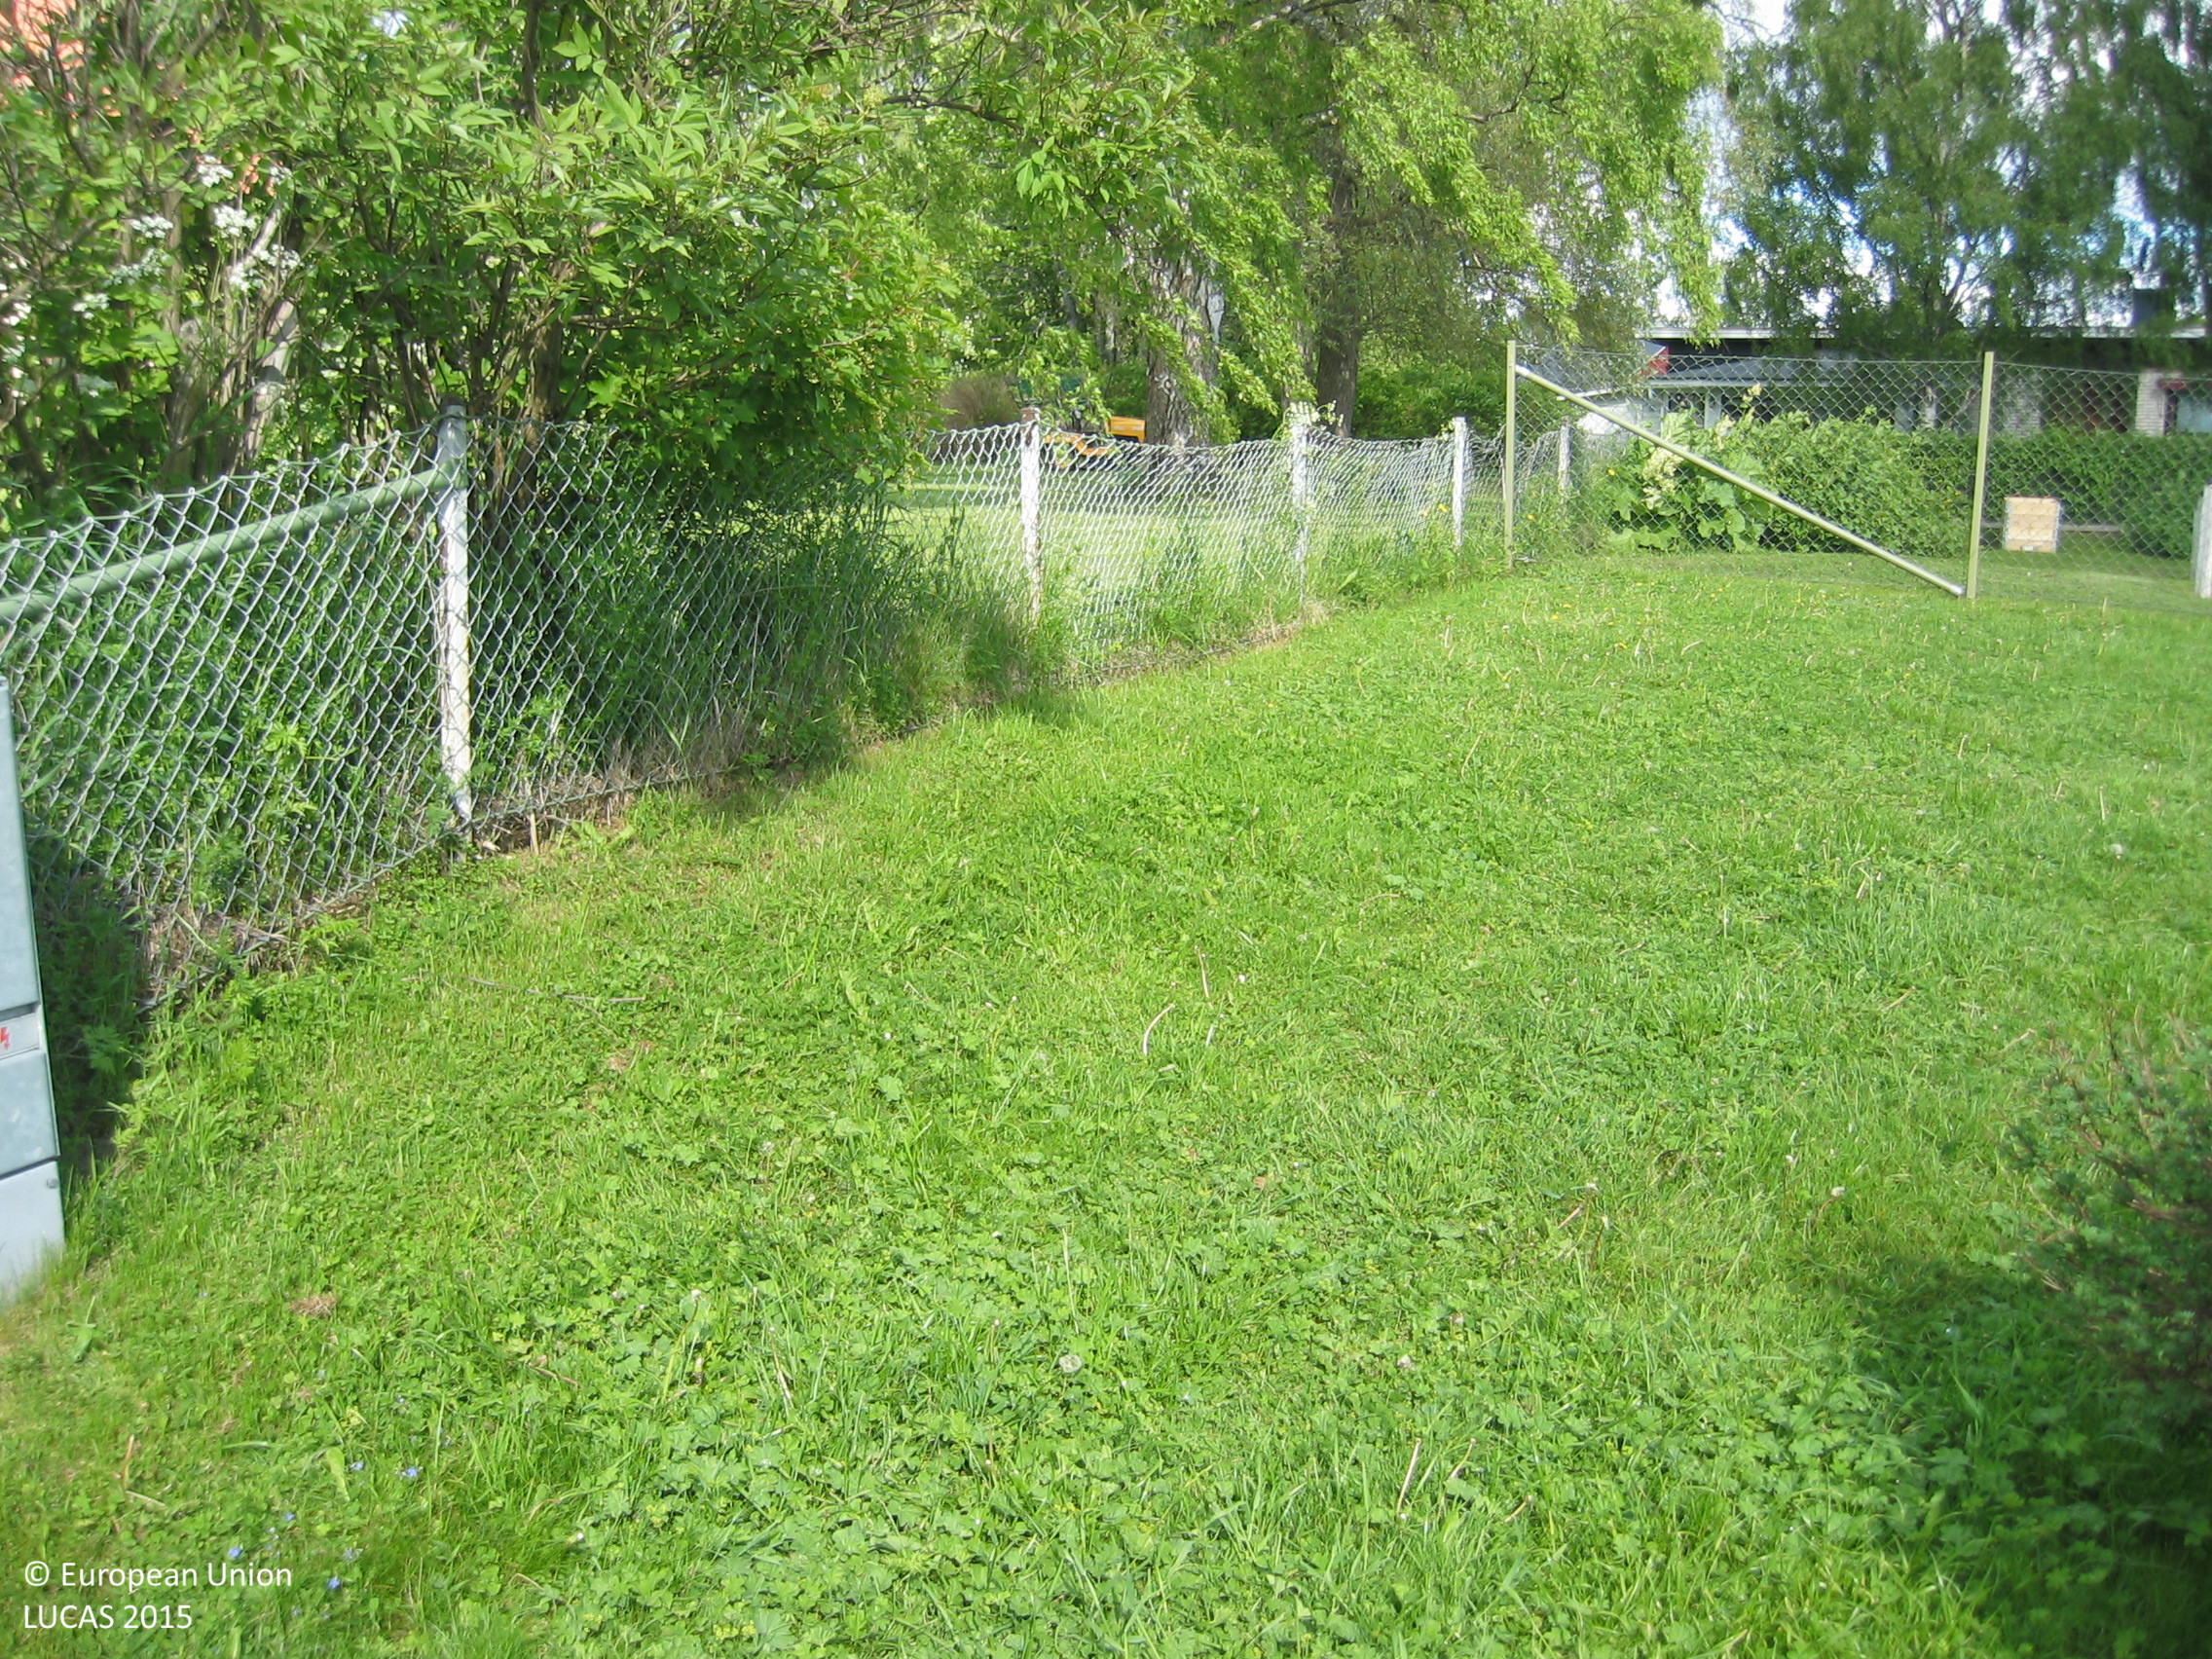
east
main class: Grassland
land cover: Grassland with sparse tree/shrub cover
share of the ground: > 75 %
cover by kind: herbaceous plants 95 %, broadleaved forest trees 5 %
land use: Residential
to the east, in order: Grassland with sparse tree/shrub cover; Artificial constructions in urban areas; Grassland with sparse tree/shrub cover; Grassland without tree/shrub cover; Groves; Artificial constructions in urban areas
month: June
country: SE
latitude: 63.5840
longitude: 15.3543
